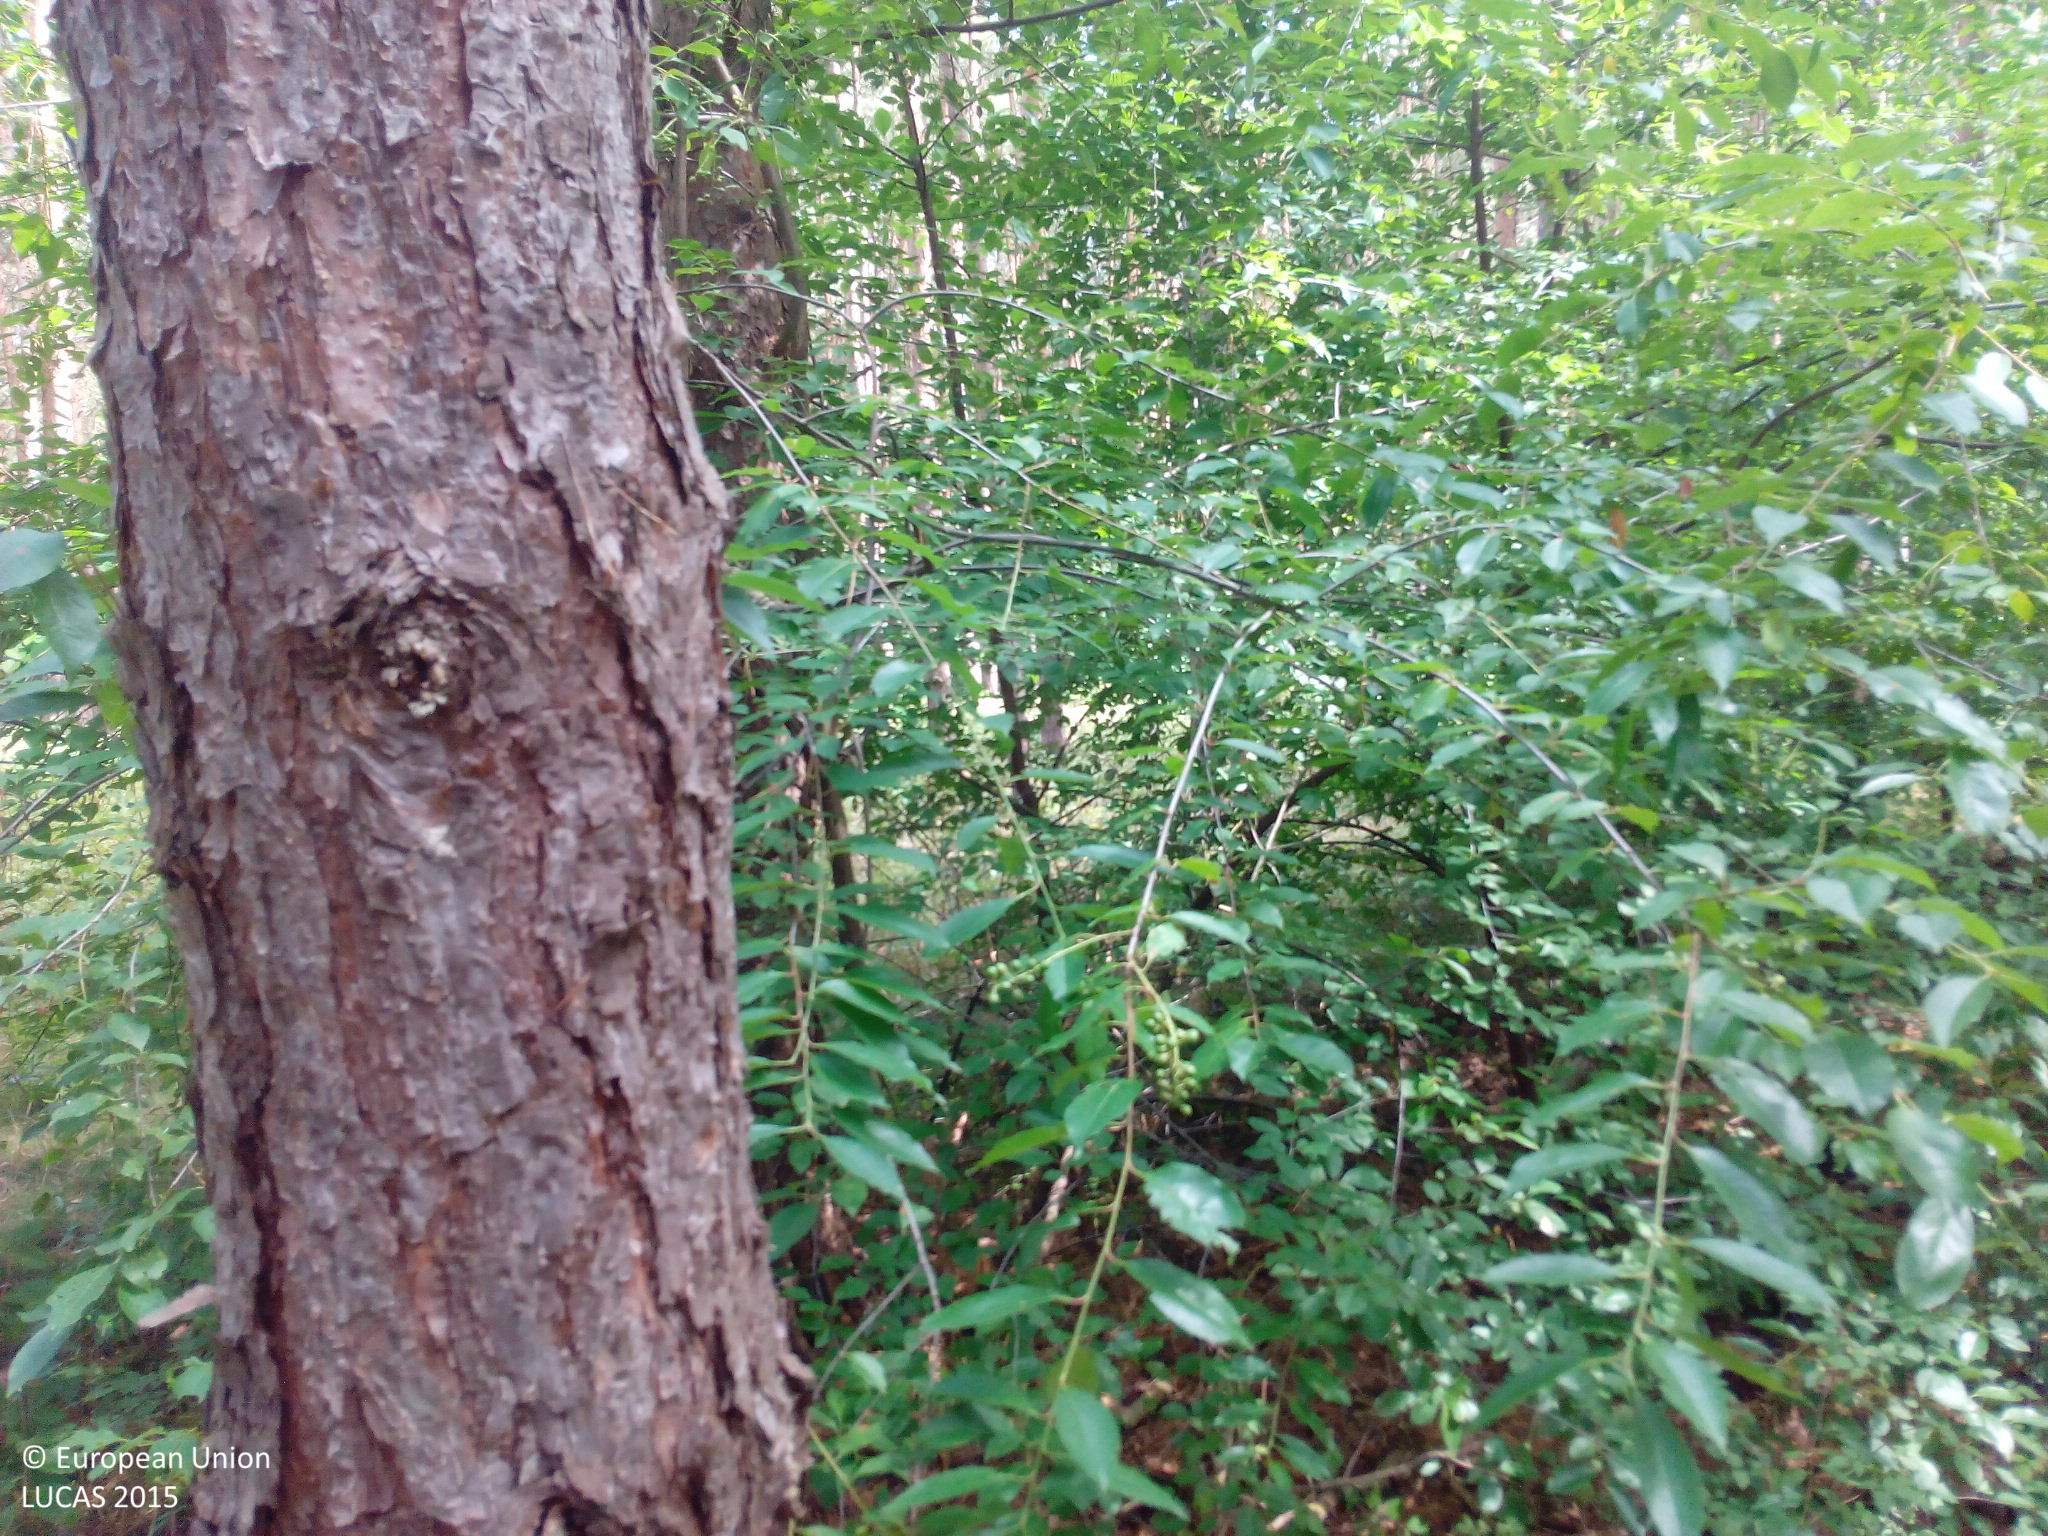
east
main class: Woodland
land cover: Pine dominated coniferous woodland
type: hemiboreal forest and nemoral coniferous forest and mixed broadleaved-coniferous forest
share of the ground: 50 - 75 %
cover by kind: coniferous forest trees 50 %, lichens and mosses 20 %, broadleaved forest trees 10 %, shrubs 10 %, herbaceous plants 10 %
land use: Forestry
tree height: > 5 m
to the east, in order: Pine dominated coniferous woodland; Paved roads, cycling and walking lanes; Broadleaved woodland; Tracks; Pine dominated mixed woodland; Broadleaved woodland
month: July
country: DE
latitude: 52.6581
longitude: 12.4389
